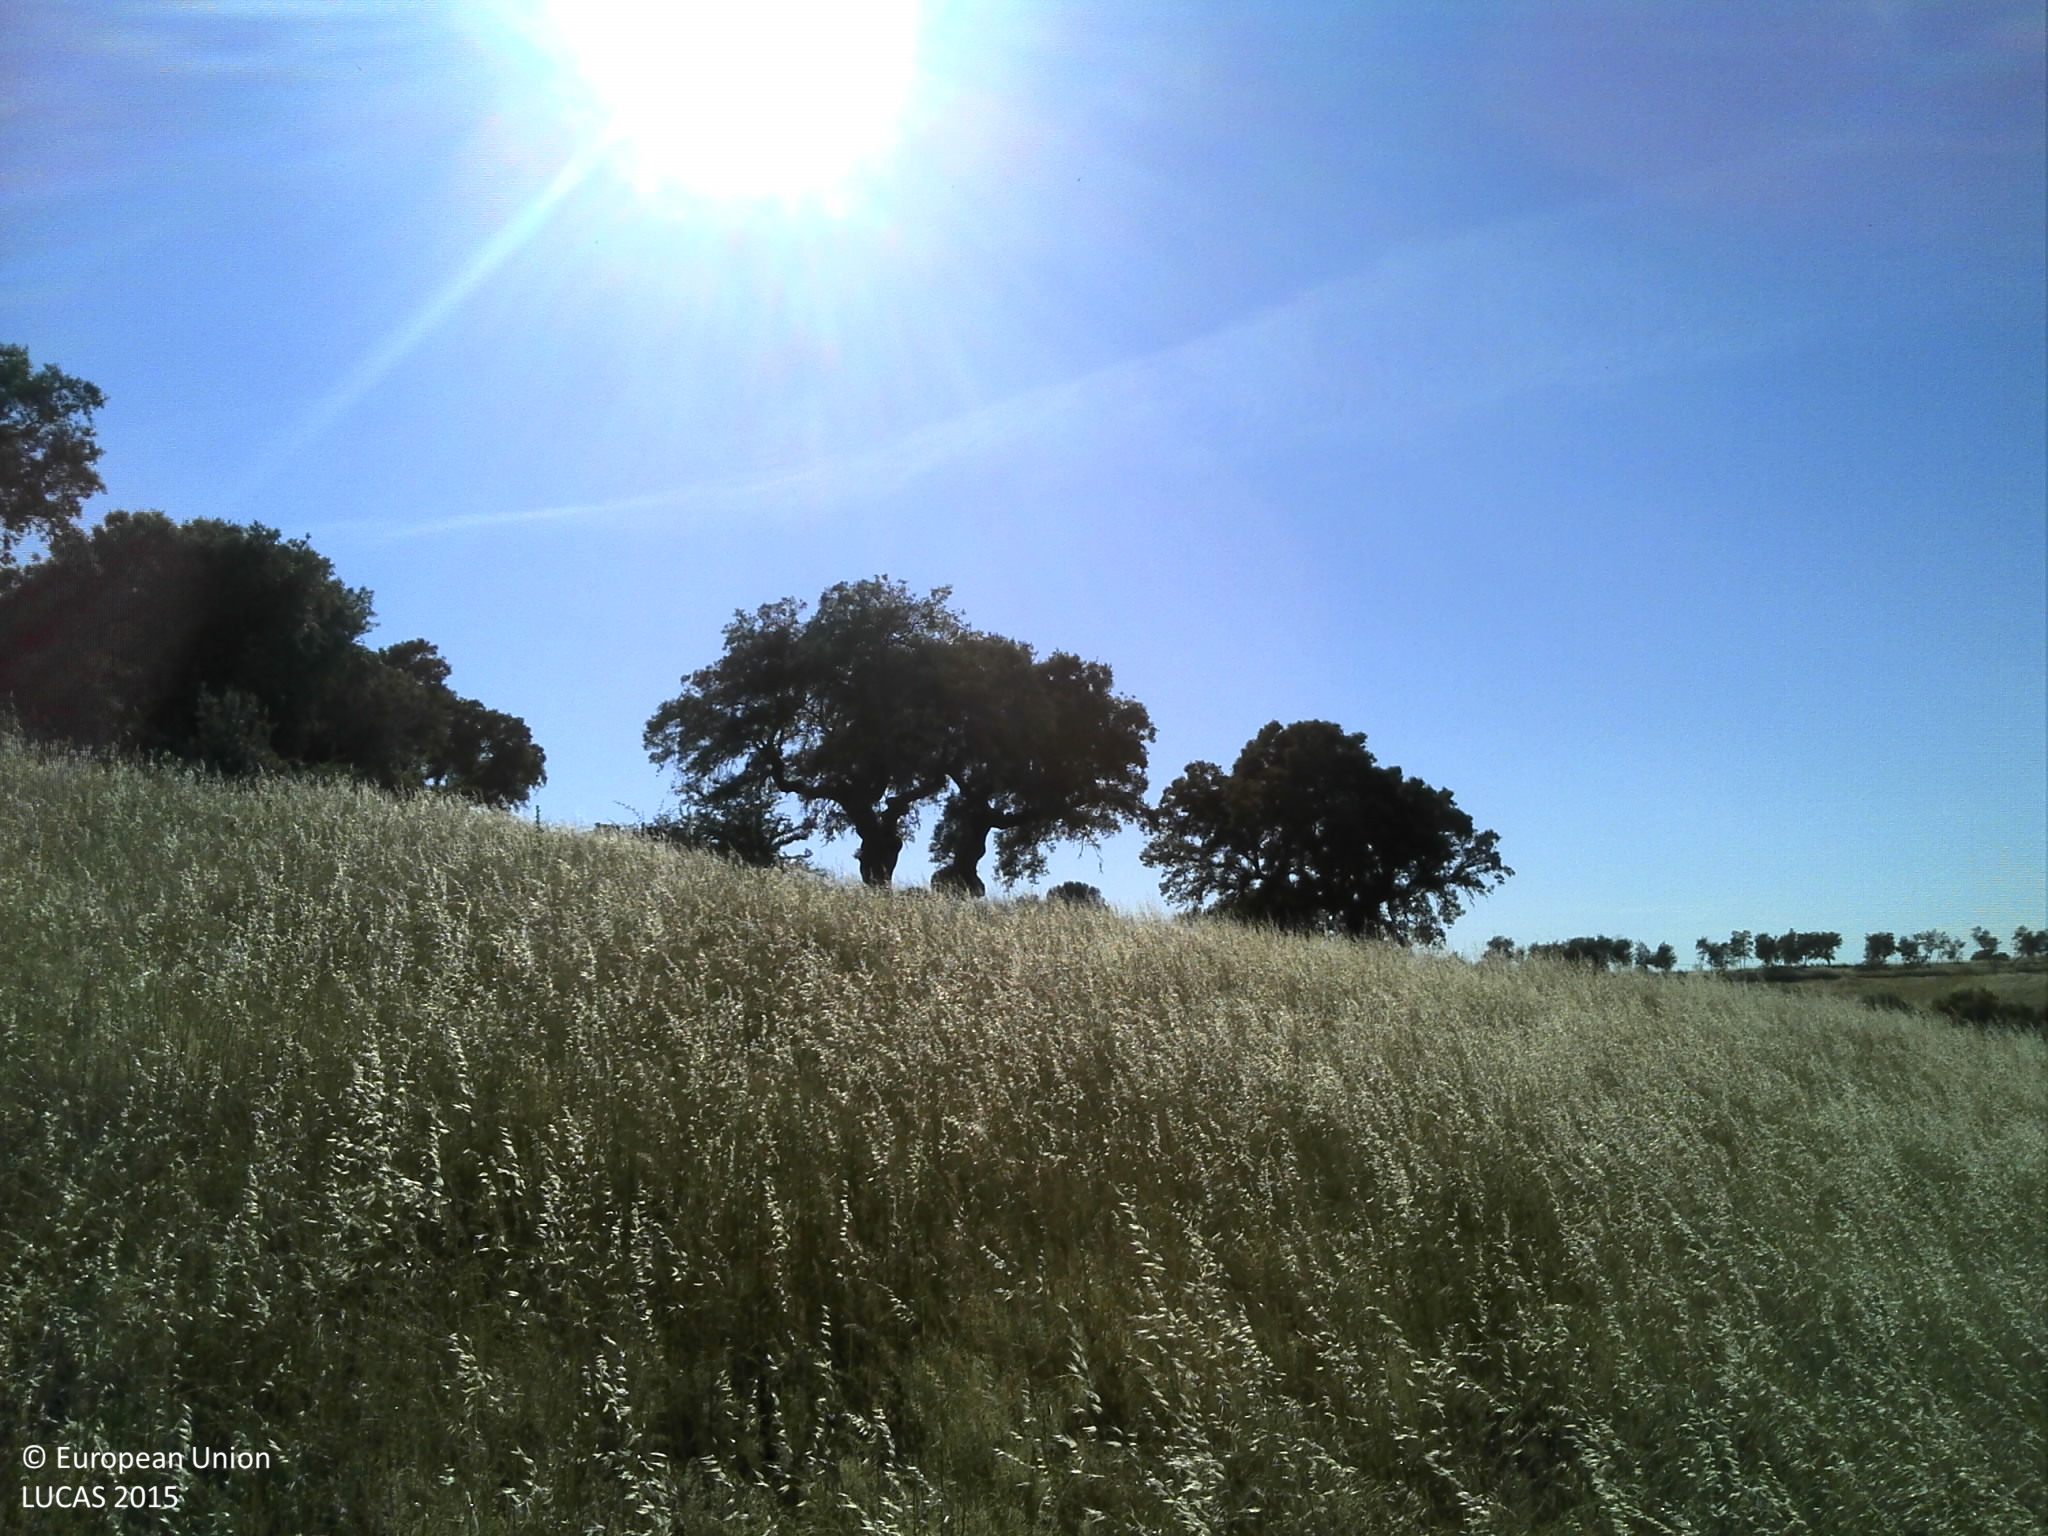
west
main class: Woodland
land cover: Broadleaved woodland
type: broadleaved evergreen forest
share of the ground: 10 - 25 %
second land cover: Grassland without tree/shrub cover
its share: 10 - 25 %
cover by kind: unconsolidated bare surface 50 %, herbaceous plants 30 %, broadleaved forest trees 15 %, shrubs 5 %
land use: Forestry
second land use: Agriculture (excluding fallow land and kitchen gardens)
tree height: > 5 m
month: May
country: PT
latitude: 39.2446
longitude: -7.6459
